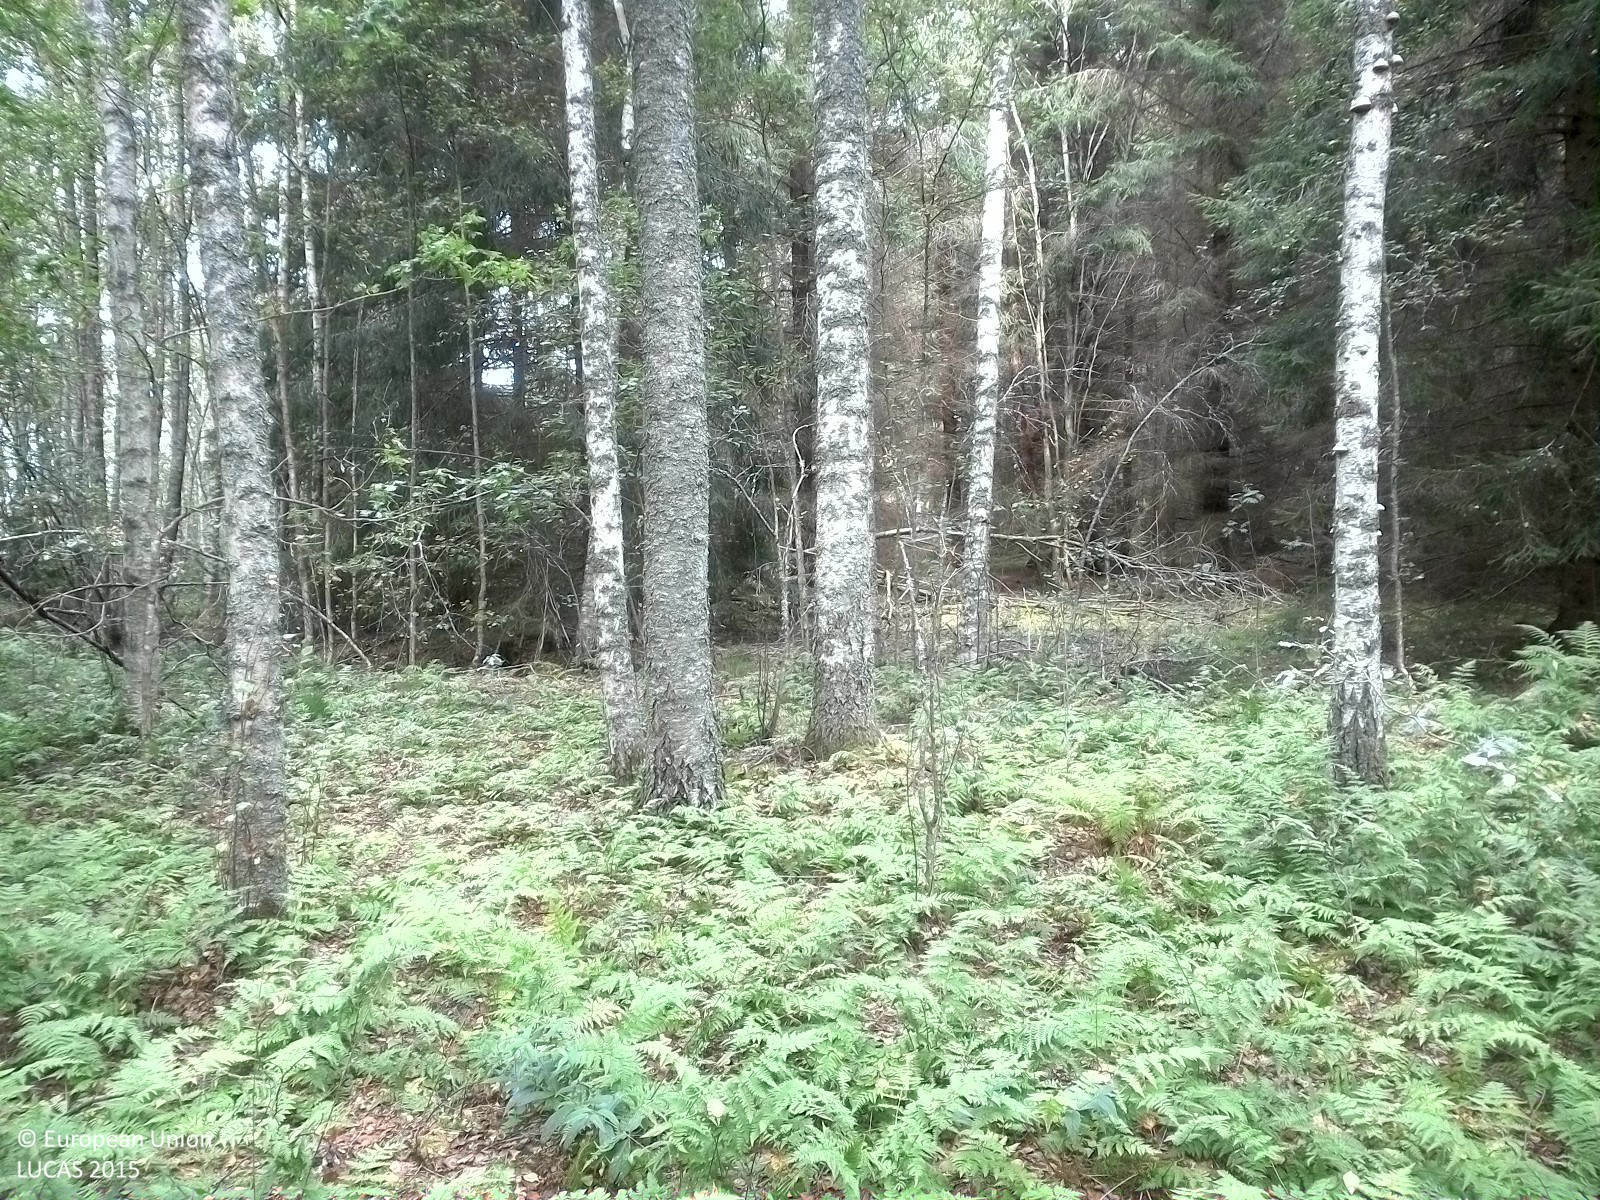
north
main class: Woodland
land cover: Broadleaved woodland
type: hemiboreal forest and nemoral coniferous forest and mixed broadleaved-coniferous forest
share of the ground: 25 - 50 %
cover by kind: broadleaved forest trees 35 %, herbaceous plants 35 %, unconsolidated bare surface 20 %, coniferous forest trees 5 %, lichens and mosses 5 %
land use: Forestry
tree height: > 5 m
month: August
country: SE
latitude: 59.3001
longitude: 15.8749
